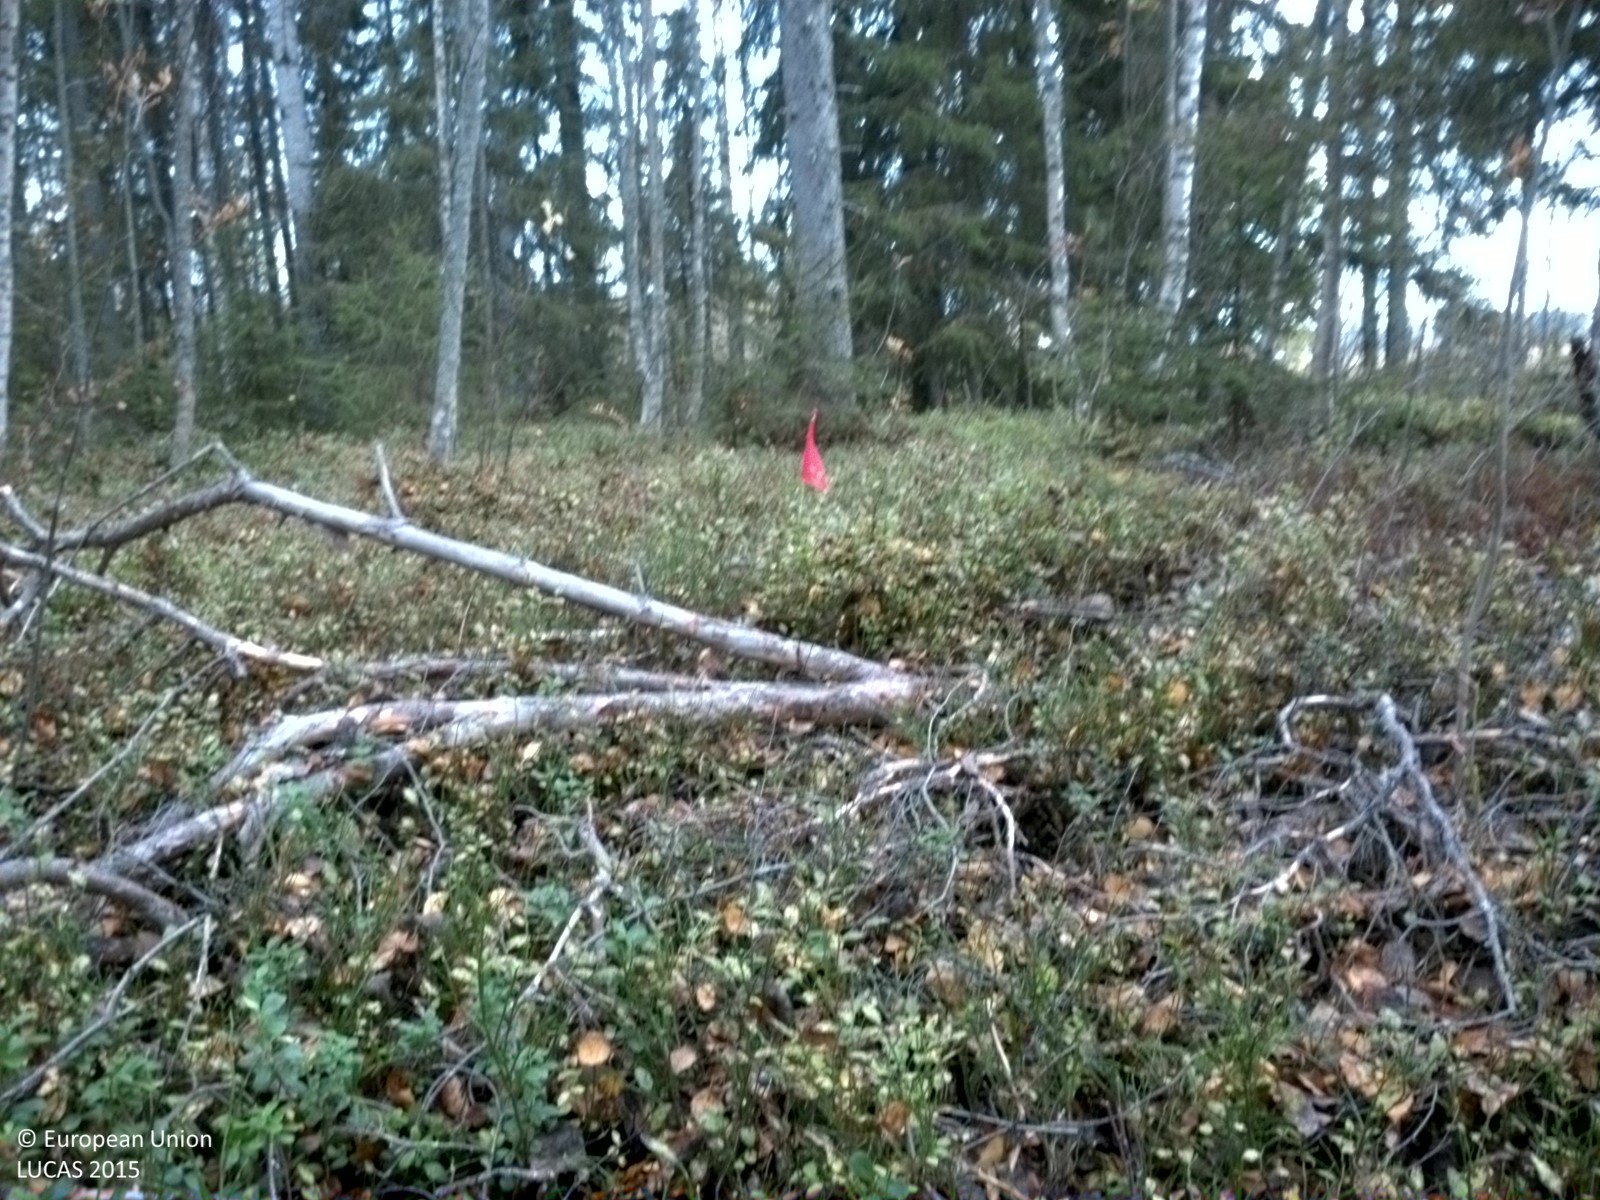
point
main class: Woodland
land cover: Spruce dominated mixed woodland
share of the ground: 25 - 50 %
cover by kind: shrubs 50 %, broadleaved forest trees 30 %, coniferous forest trees 20 %
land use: Forestry
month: October
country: SE
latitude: 65.6340
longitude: 21.9022
